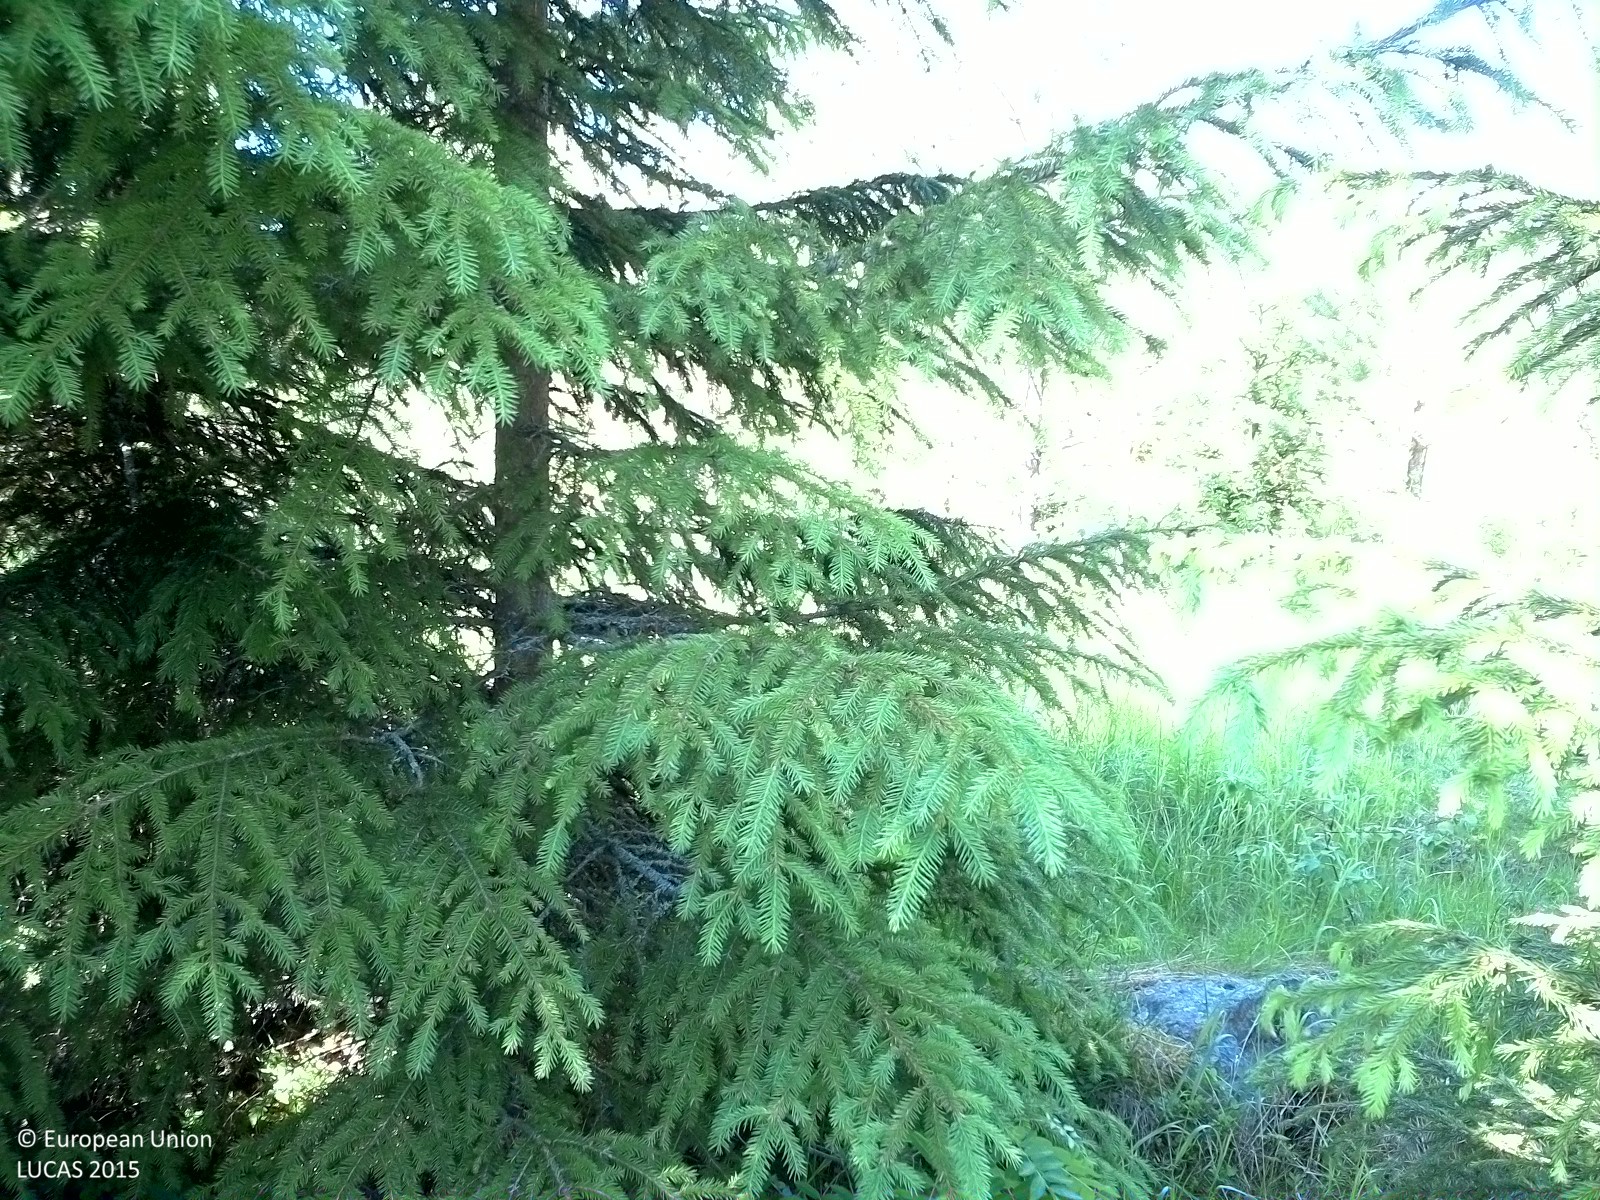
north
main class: Woodland
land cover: Spruce dominated coniferous woodland
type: boreal forest
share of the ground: 25 - 50 %
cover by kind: herbaceous plants 55 %, coniferous forest trees 45 %
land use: Forestry
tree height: > 5 m
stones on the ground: < 10 %
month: July
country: SE
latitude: 62.2177
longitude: 16.9234
